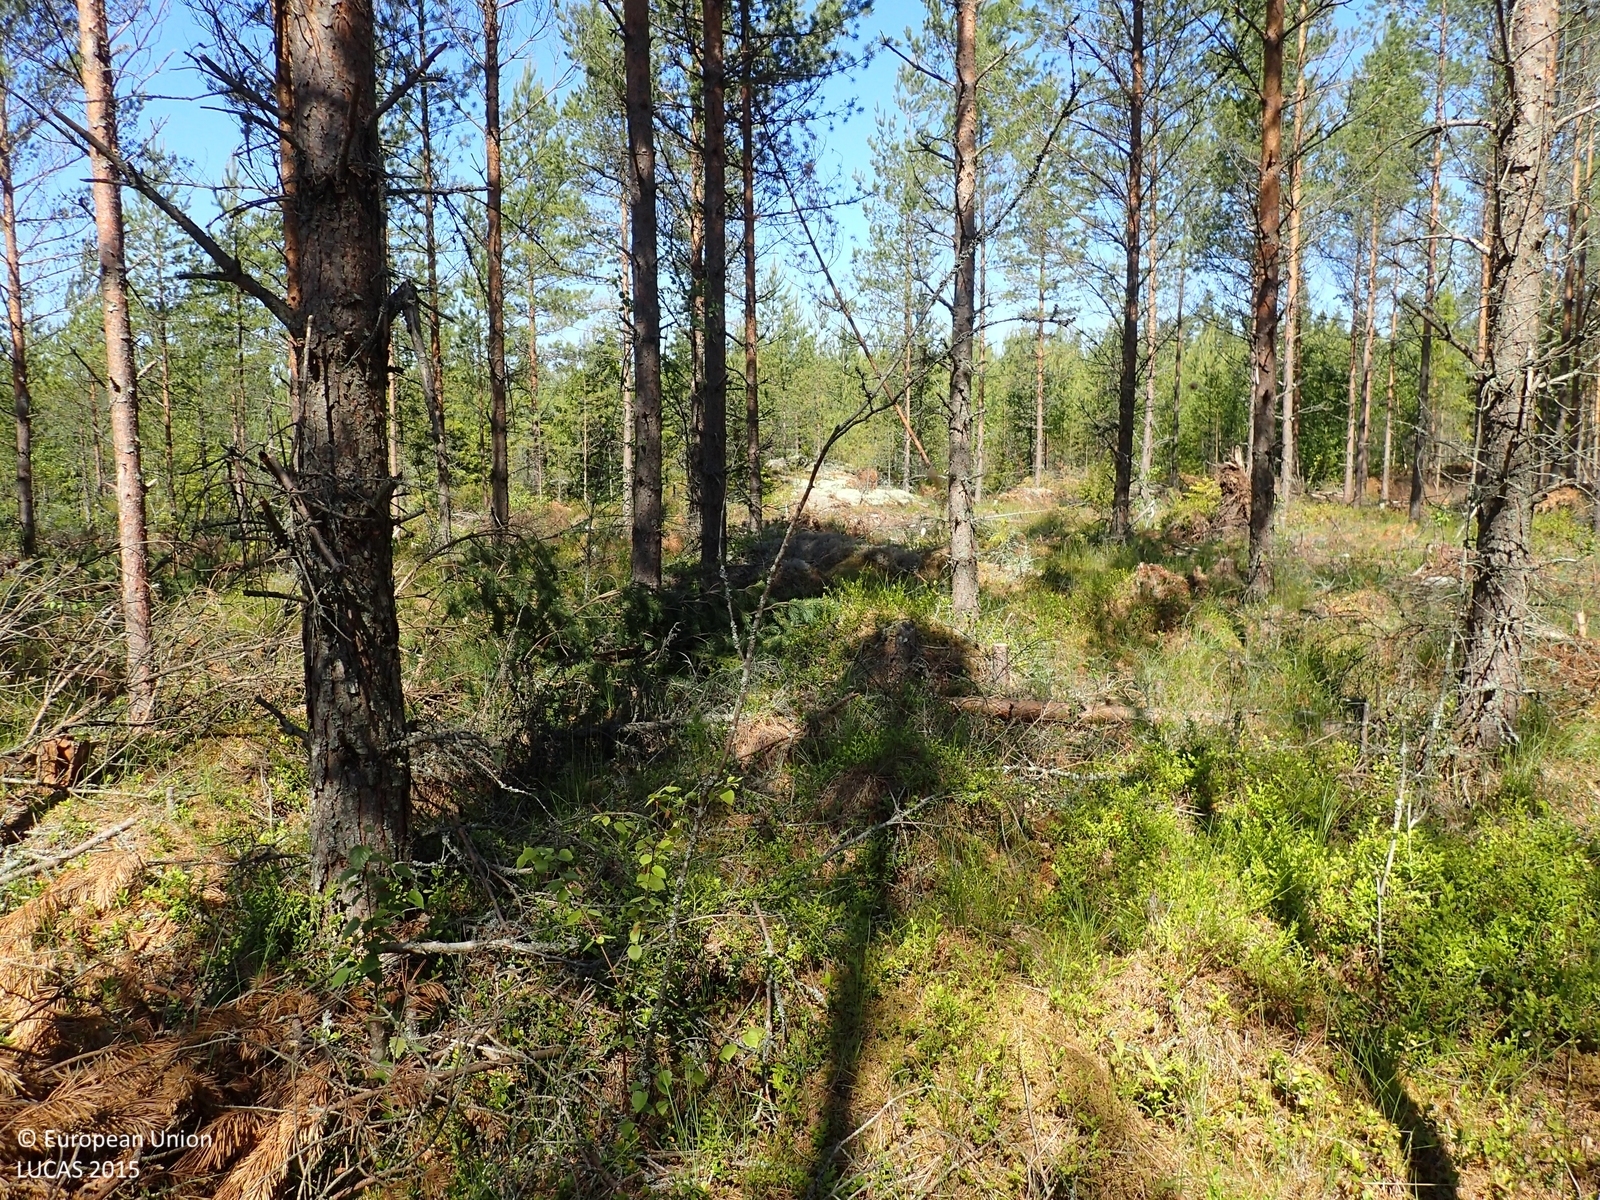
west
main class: Woodland
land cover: Pine dominated coniferous woodland
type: mire and swamp forests
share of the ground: 25 - 50 %
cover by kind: shrubs 50 %, coniferous forest trees 40 %, herbaceous plants 5 %, lichens and mosses 5 %
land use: Forestry
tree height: > 5 m
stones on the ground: < 10 %
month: June
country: FI
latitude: 62.4532
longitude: 21.3810
